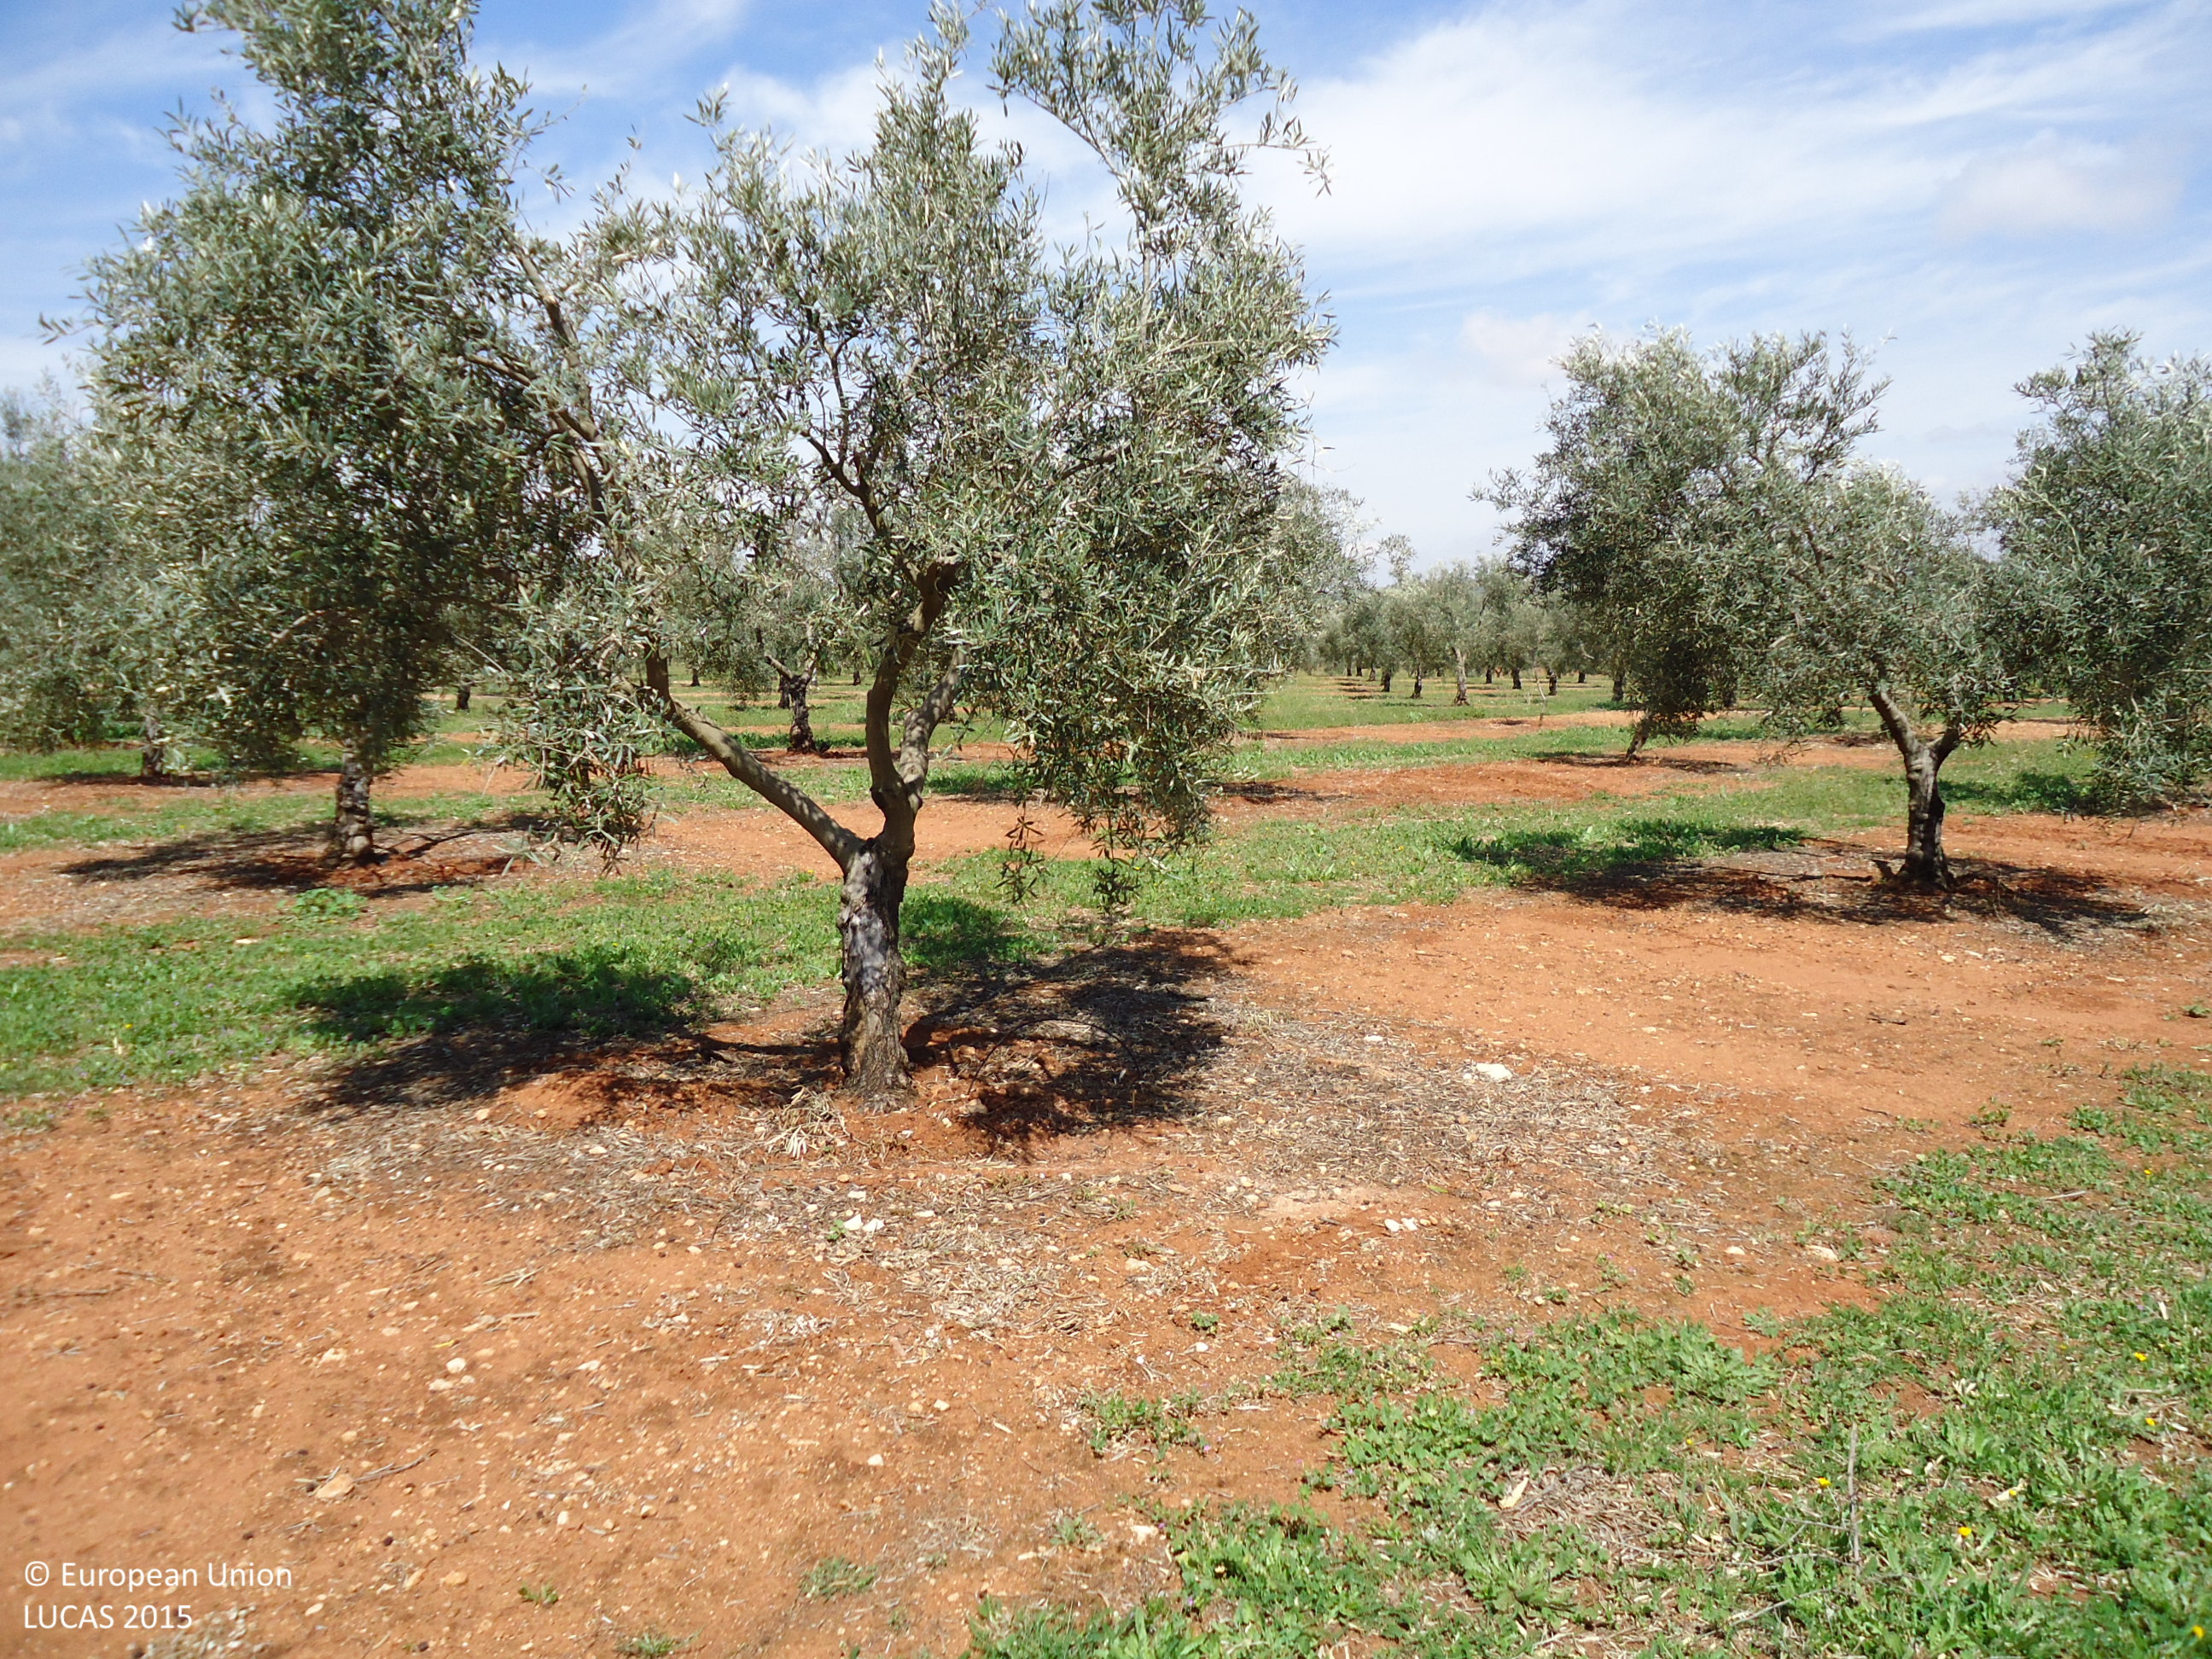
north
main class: Cropland
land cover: Olive groves
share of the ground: 25 - 50 %
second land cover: Spontaneously vegetated surfaces
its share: 50 - 75 %
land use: Agriculture (excluding fallow land and kitchen gardens)
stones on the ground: < 10 %
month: April
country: ES
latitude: 37.0735
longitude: -4.8370
